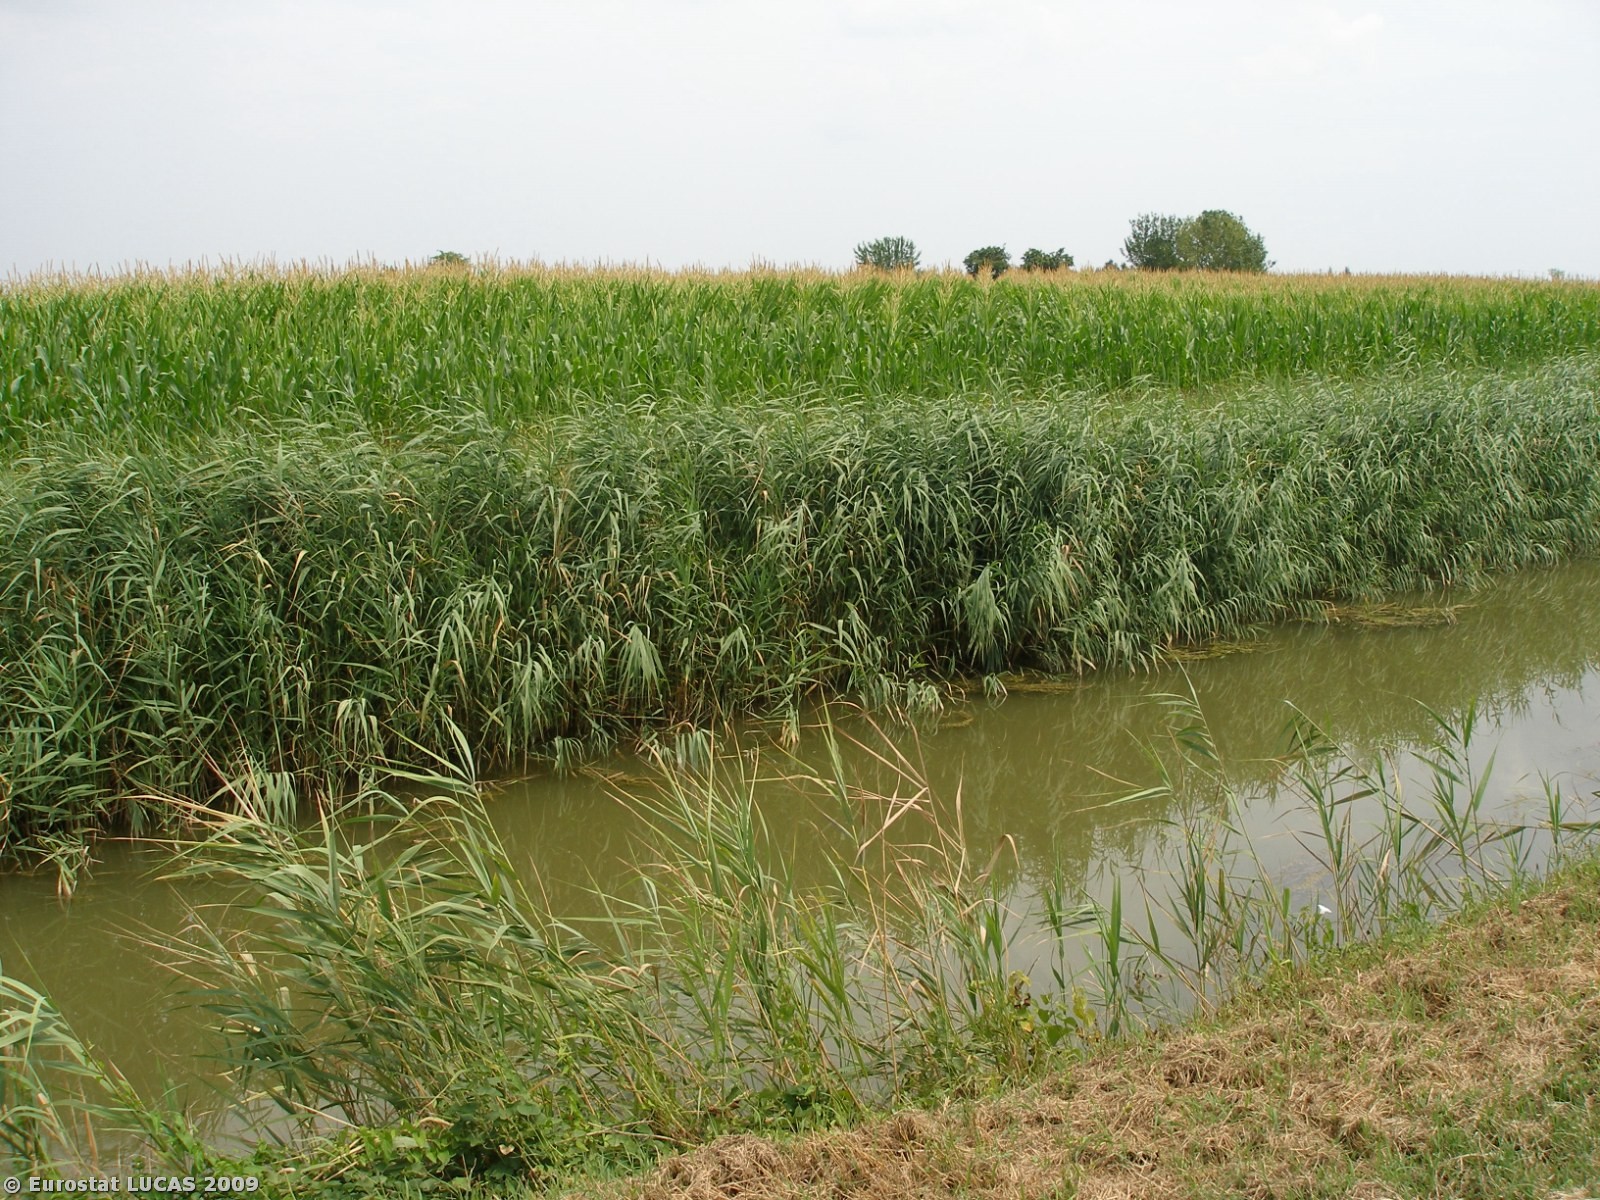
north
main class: Cropland
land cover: Maize
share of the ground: > 75 %
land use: Agriculture (excluding fallow land and kitchen gardens)
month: July
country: IT
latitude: 44.9979
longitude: 12.0386
